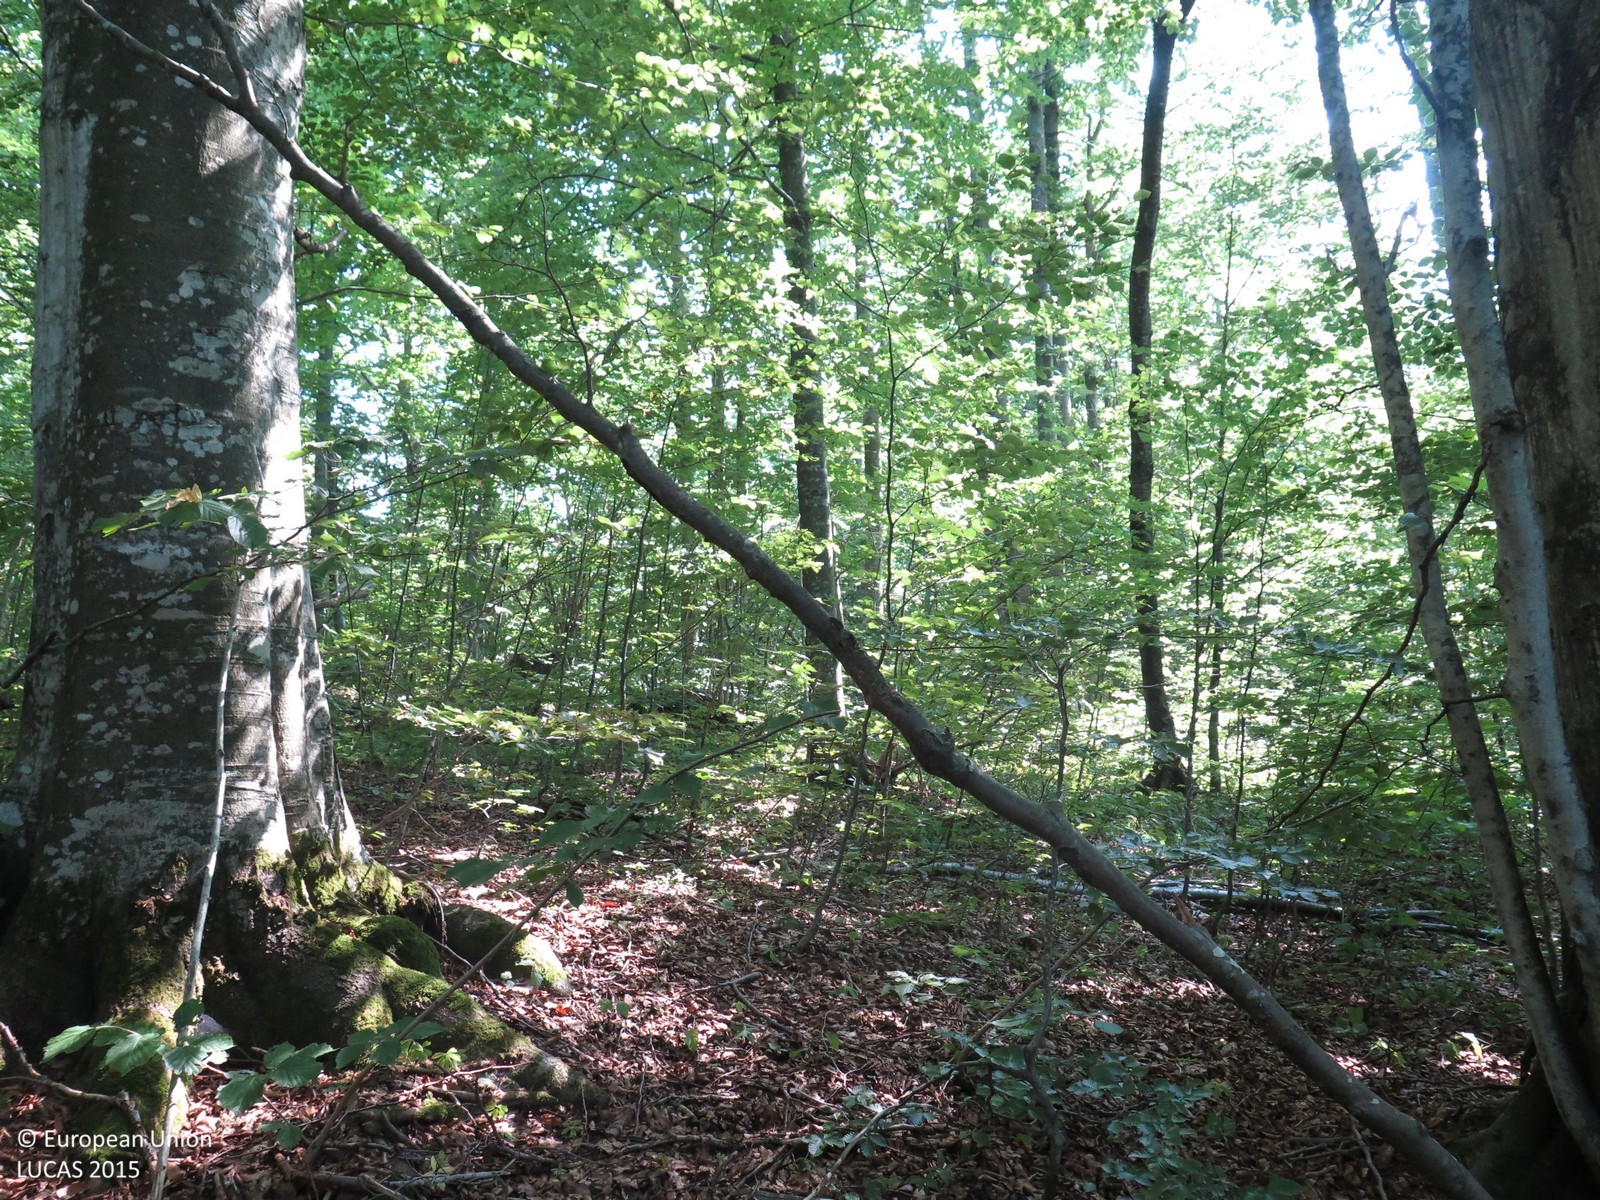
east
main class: Woodland
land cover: Broadleaved woodland
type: beech forest
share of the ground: > 75 %
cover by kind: broadleaved forest trees 95 %, unconsolidated bare surface 5 %
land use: Forestry
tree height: > 5 m
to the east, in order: Broadleaved woodland
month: August
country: HR
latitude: 45.3745
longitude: 14.8604
